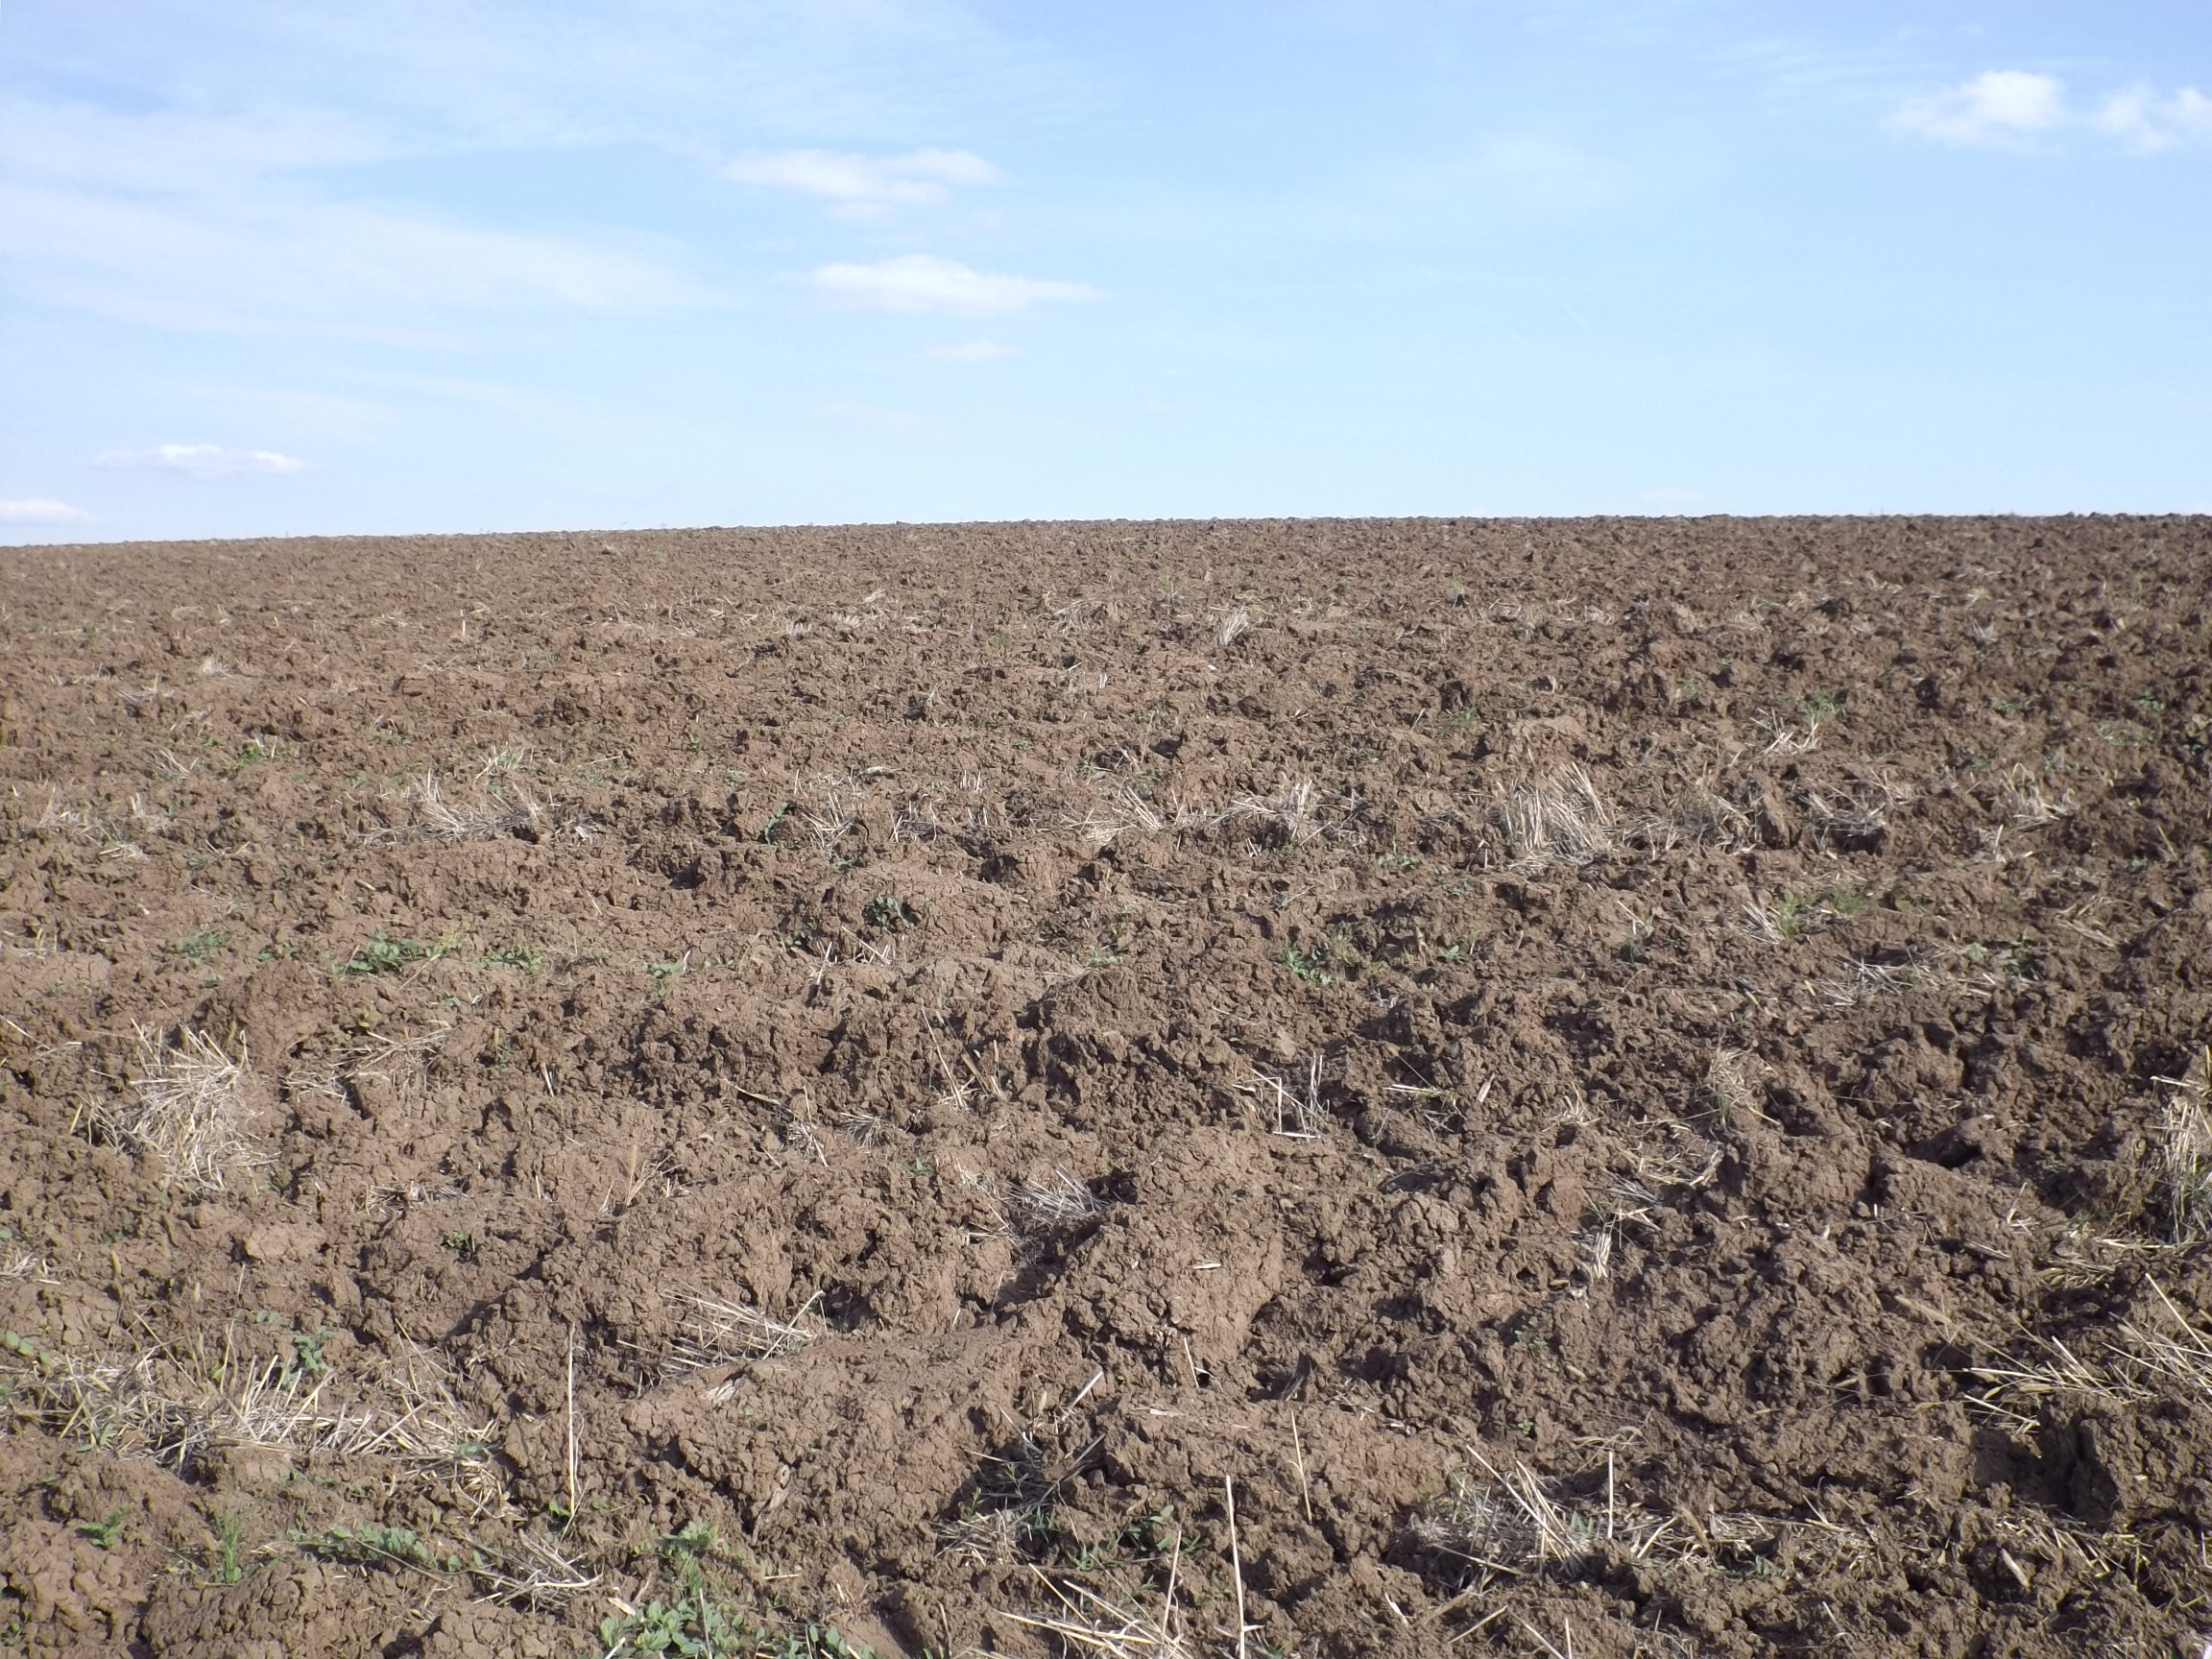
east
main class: Cropland
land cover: Common wheat
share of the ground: < 10 %
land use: Agriculture (excluding fallow land and kitchen gardens)
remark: Harvested field
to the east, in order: Common wheat
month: October
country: BG
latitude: 43.8681
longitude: 26.7009
